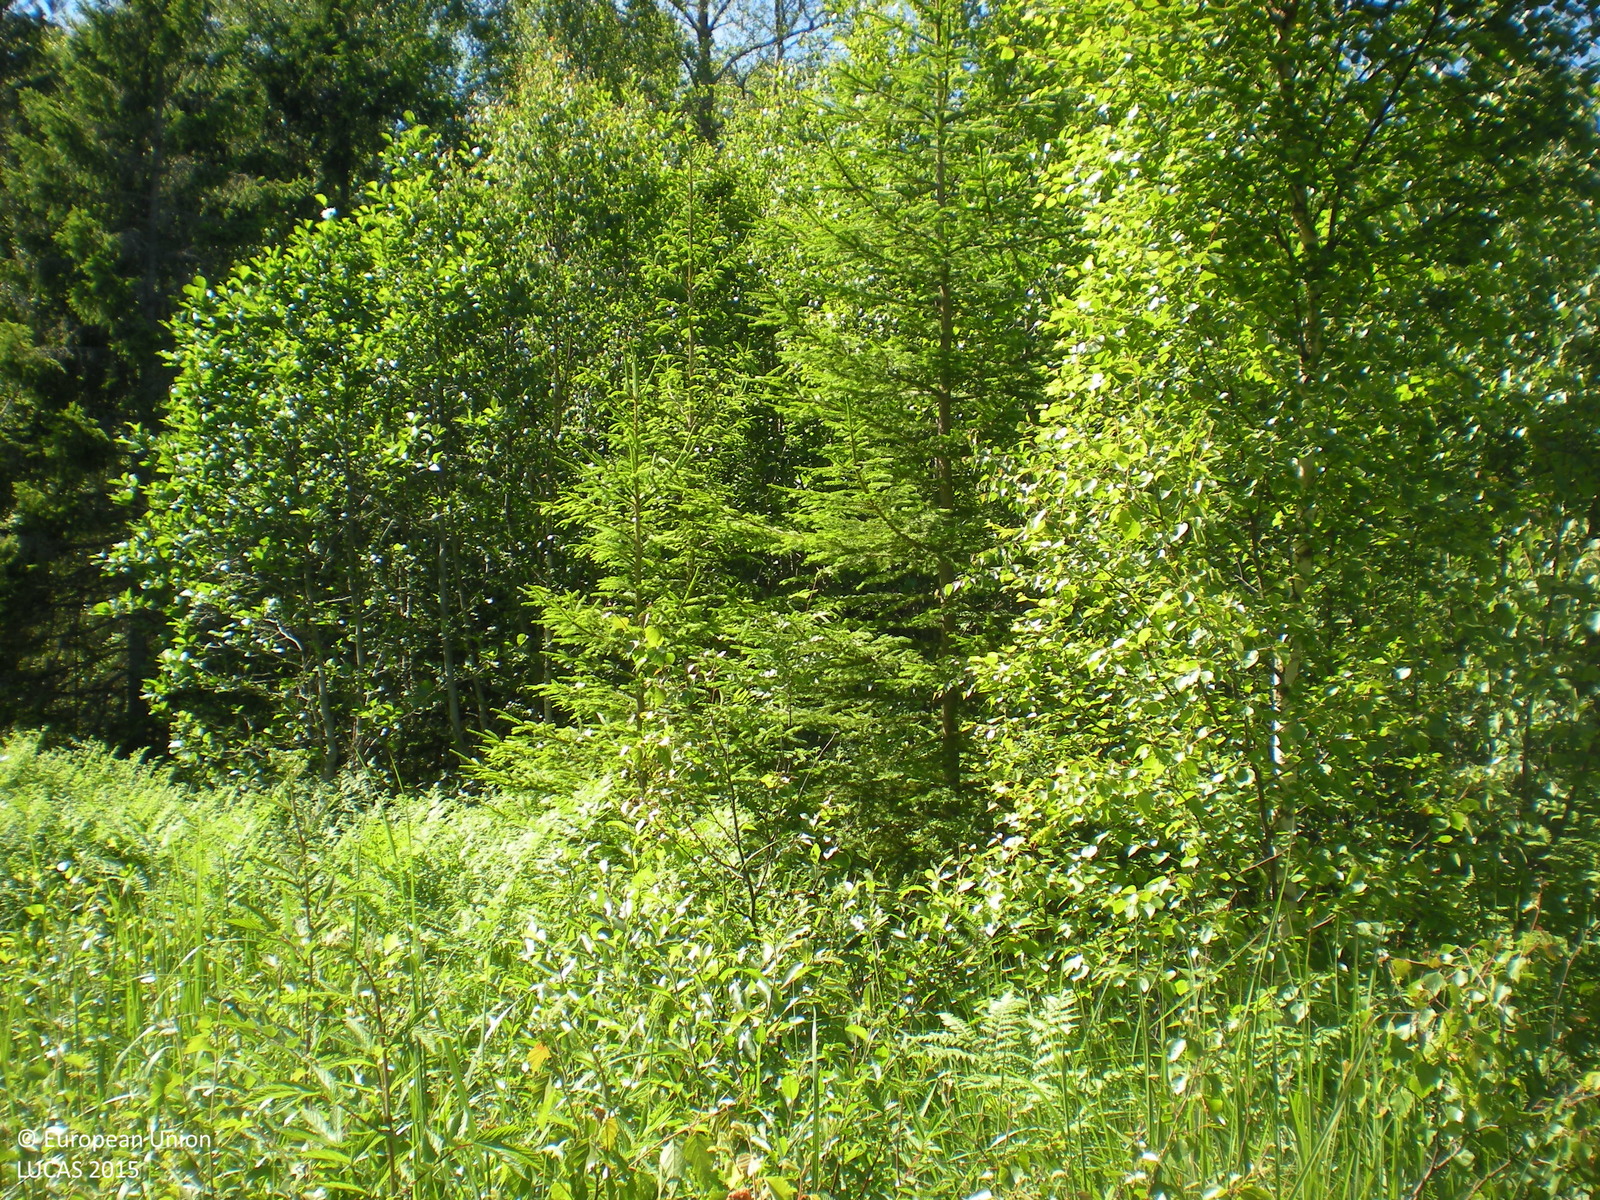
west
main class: Grassland
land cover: Grassland with sparse tree/shrub cover
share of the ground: > 75 %
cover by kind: herbaceous plants 85 %, shrubs 10 %, broadleaved forest trees 5 %
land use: Electricity, gas and thermal power distribution
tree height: < 5 m
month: July
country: SE
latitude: 60.5909
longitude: 17.9336
